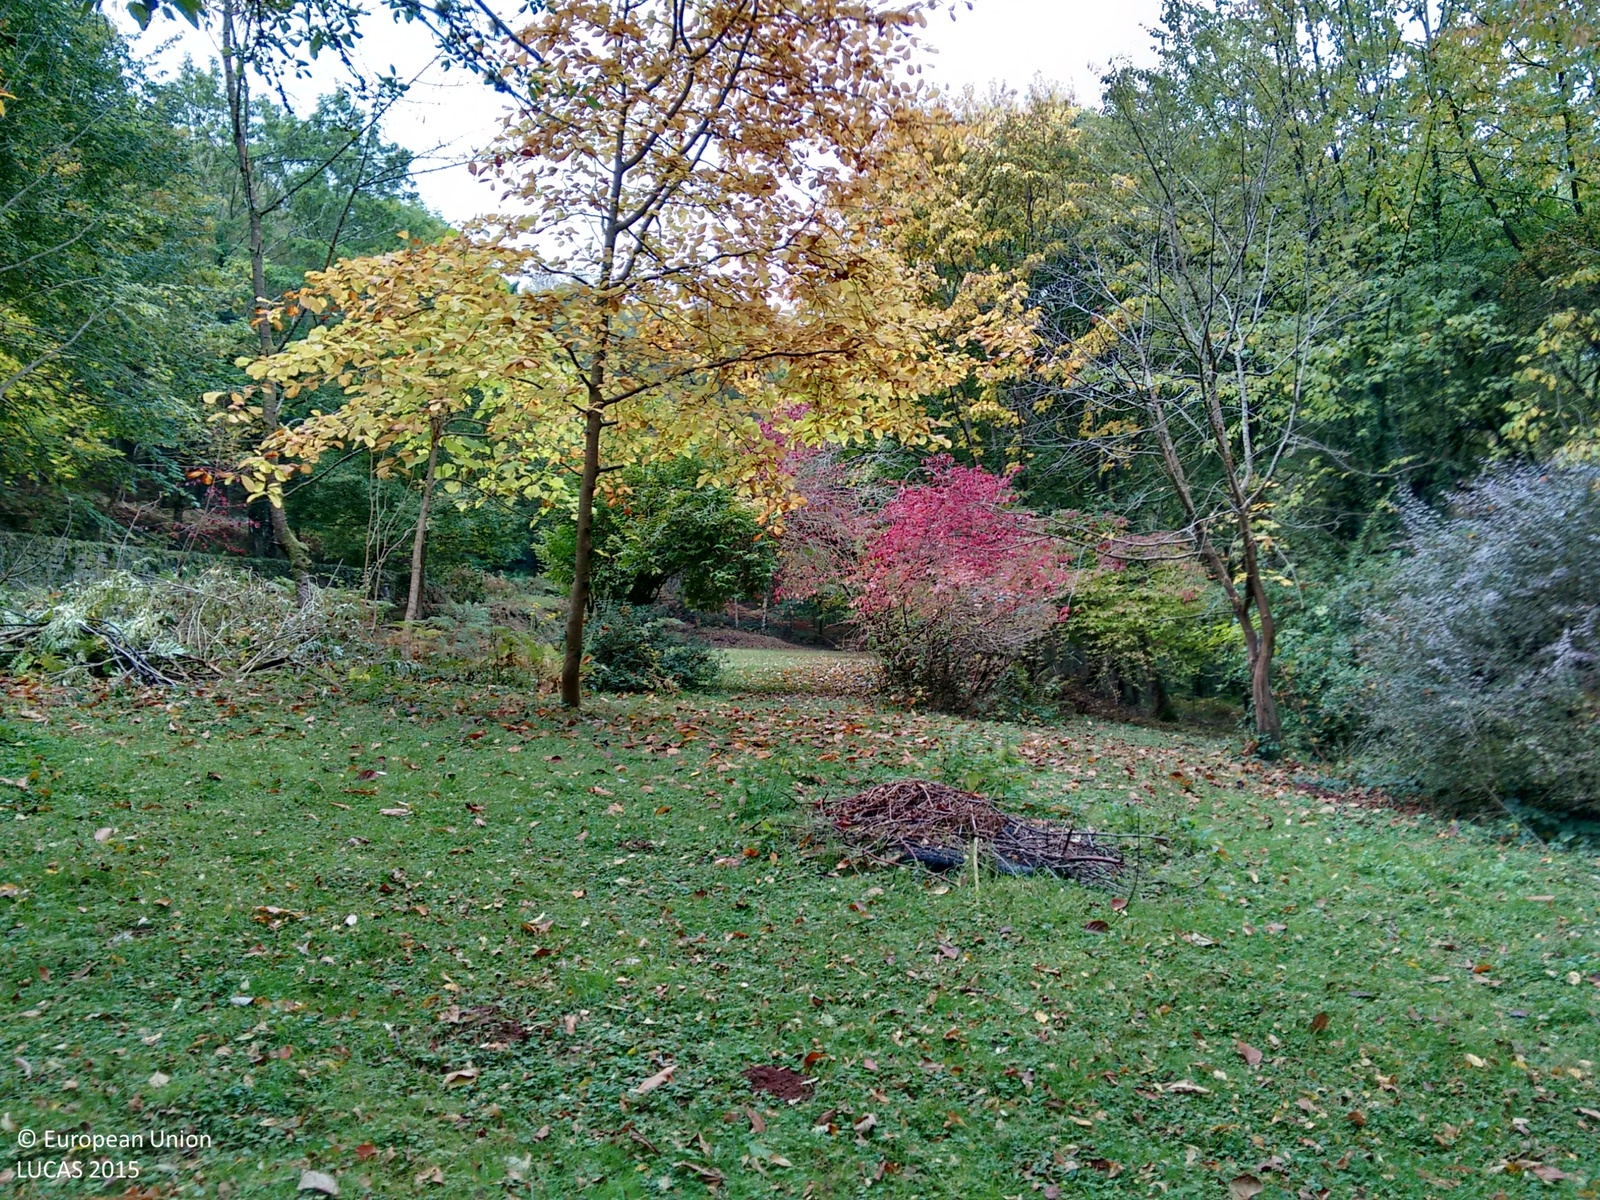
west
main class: Woodland
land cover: Broadleaved woodland
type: mesophytic deciduous forest
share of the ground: > 75 %
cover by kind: broadleaved forest trees 60 %, shrubs 20 %, herbaceous plants 20 %
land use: Residential
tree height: > 5 m
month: October
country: GB
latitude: 51.7335
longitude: -2.6520
